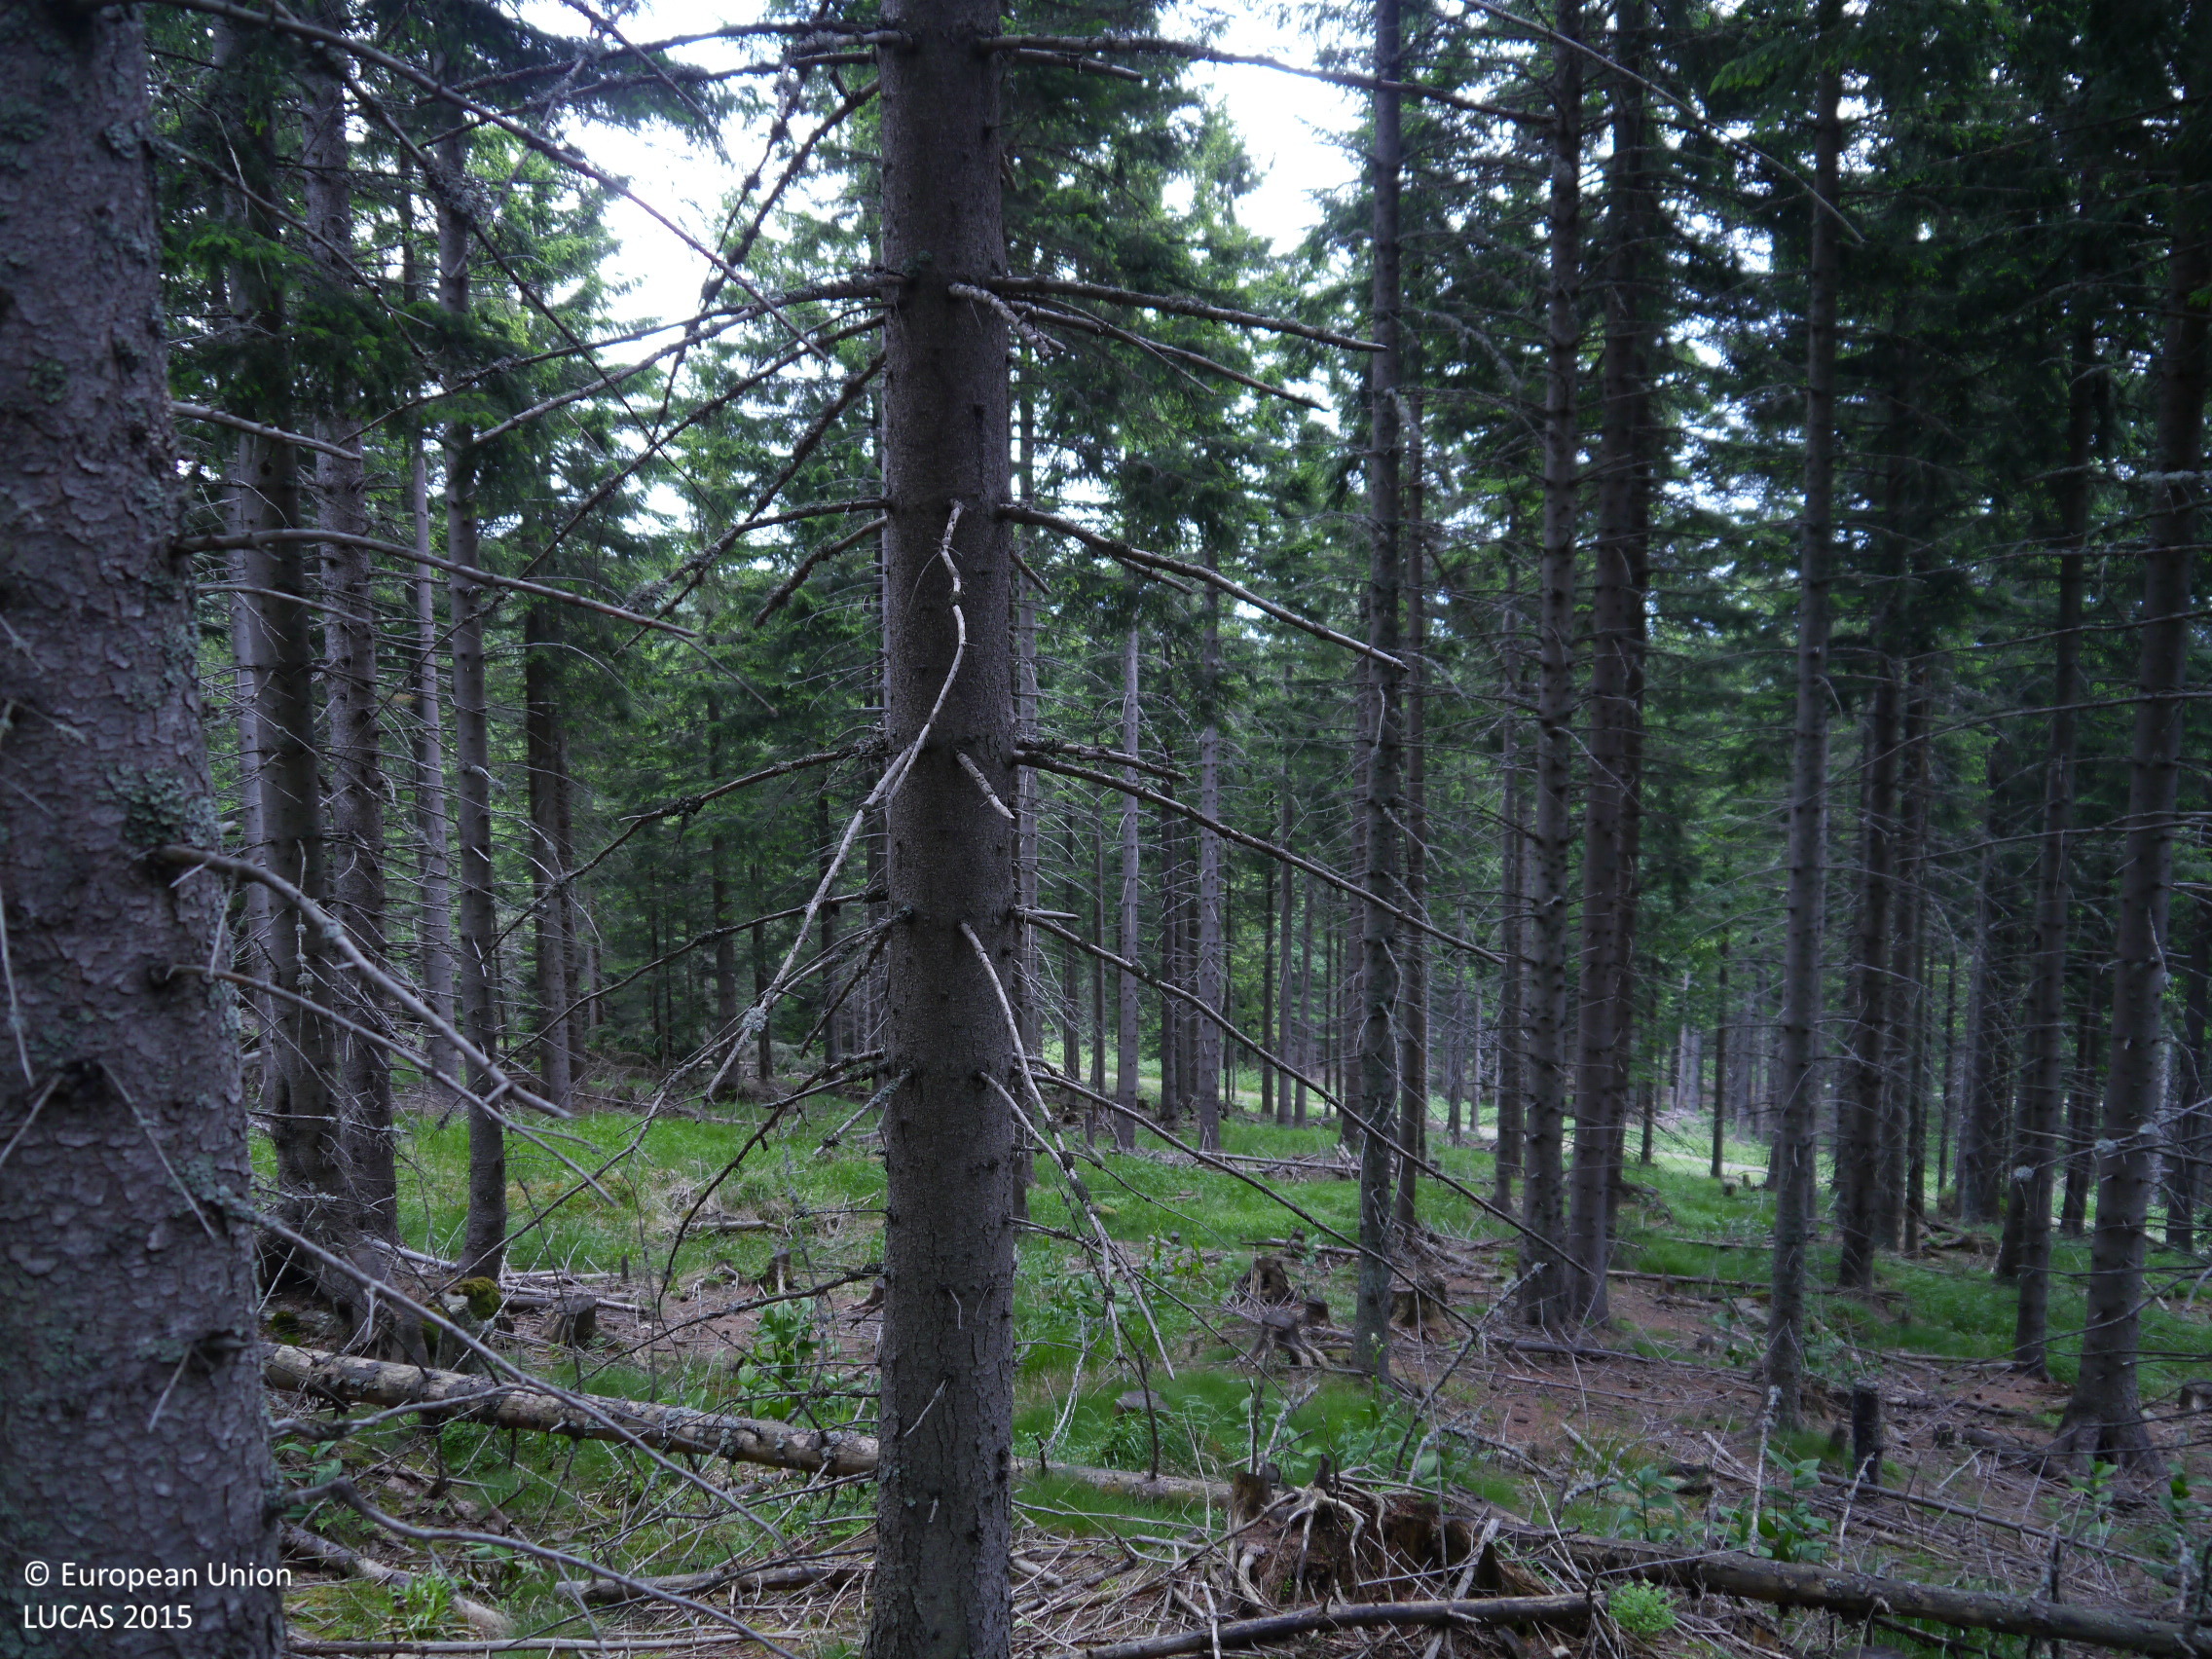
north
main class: Woodland
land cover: Spruce dominated coniferous woodland
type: alpine coniferous forest
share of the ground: > 75 %
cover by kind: coniferous forest trees 100 %
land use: Forestry
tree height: > 5 m
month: June
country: AT
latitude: 46.7533
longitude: 15.0910
